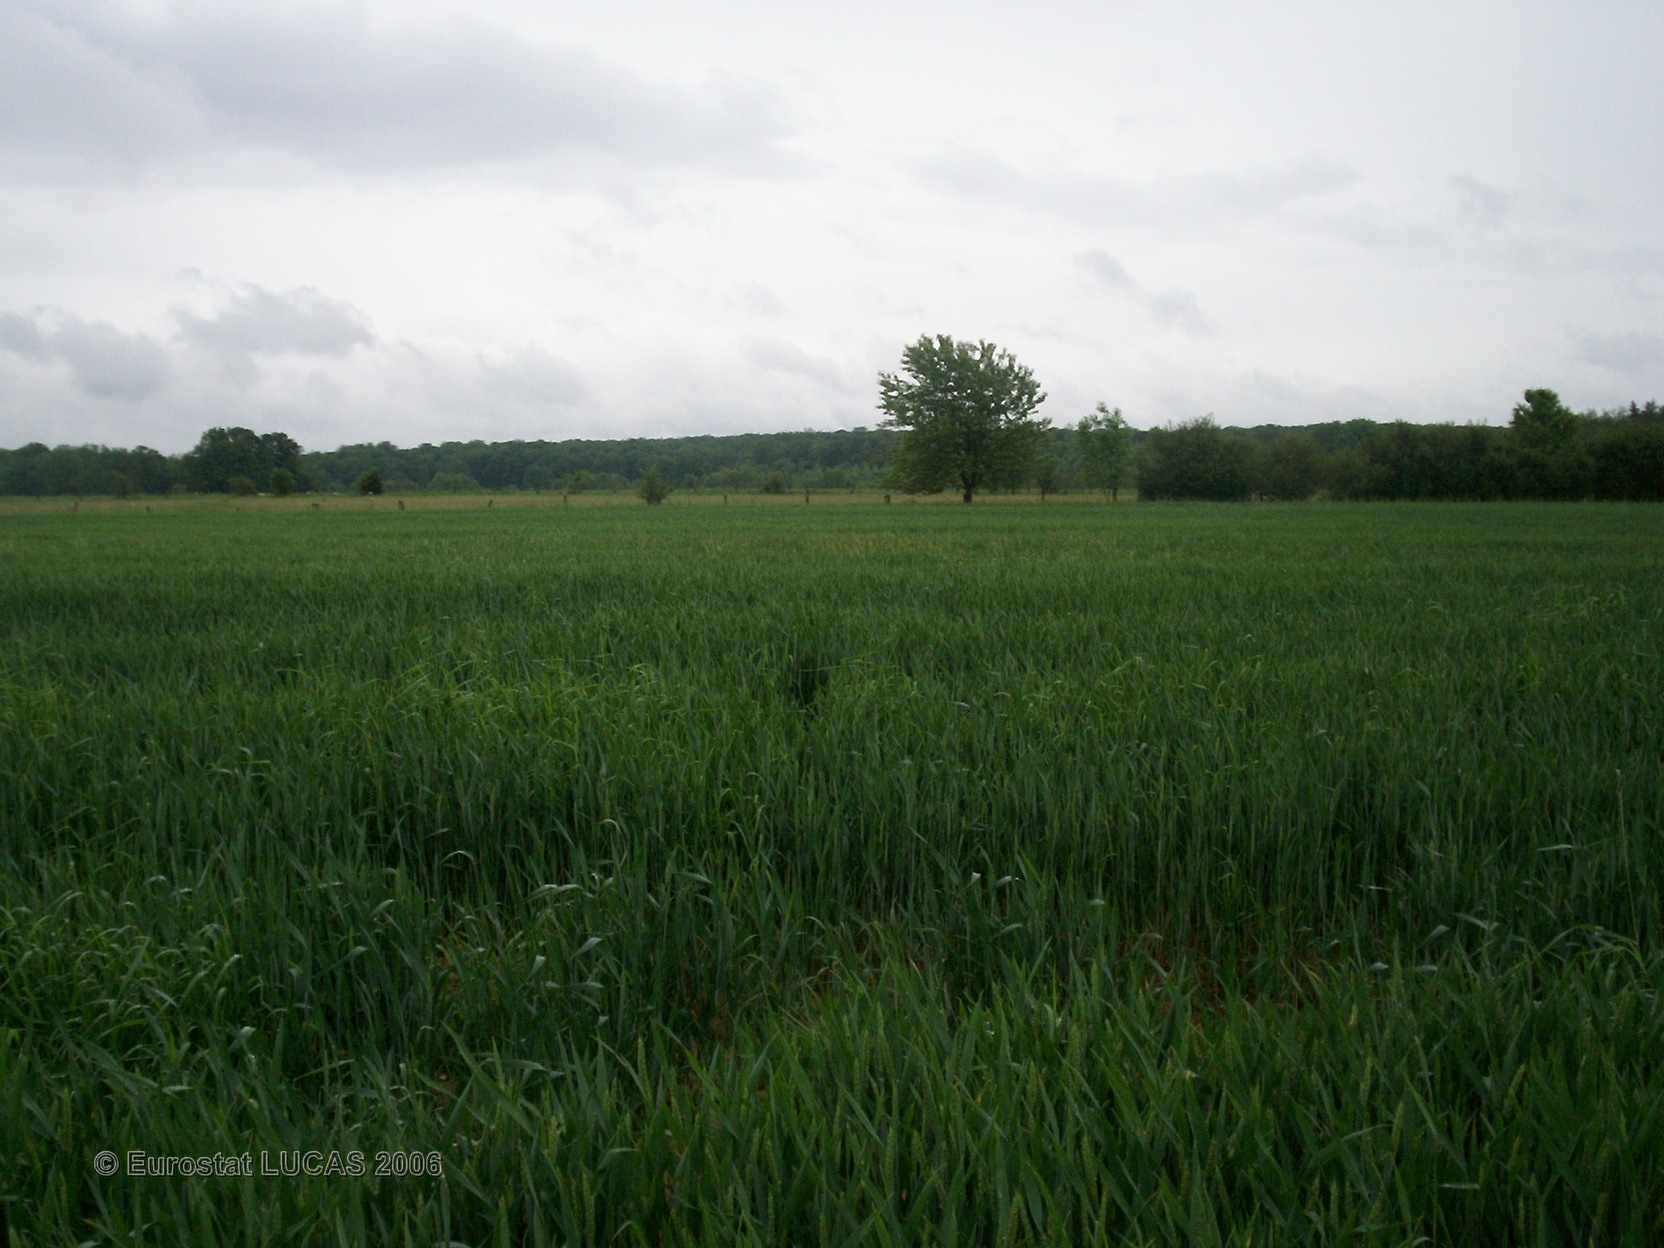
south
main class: Cropland
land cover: Common wheat
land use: Agriculture (excluding fallow land and kitchen gardens)
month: May
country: FR
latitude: 48.5542
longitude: 6.7626
